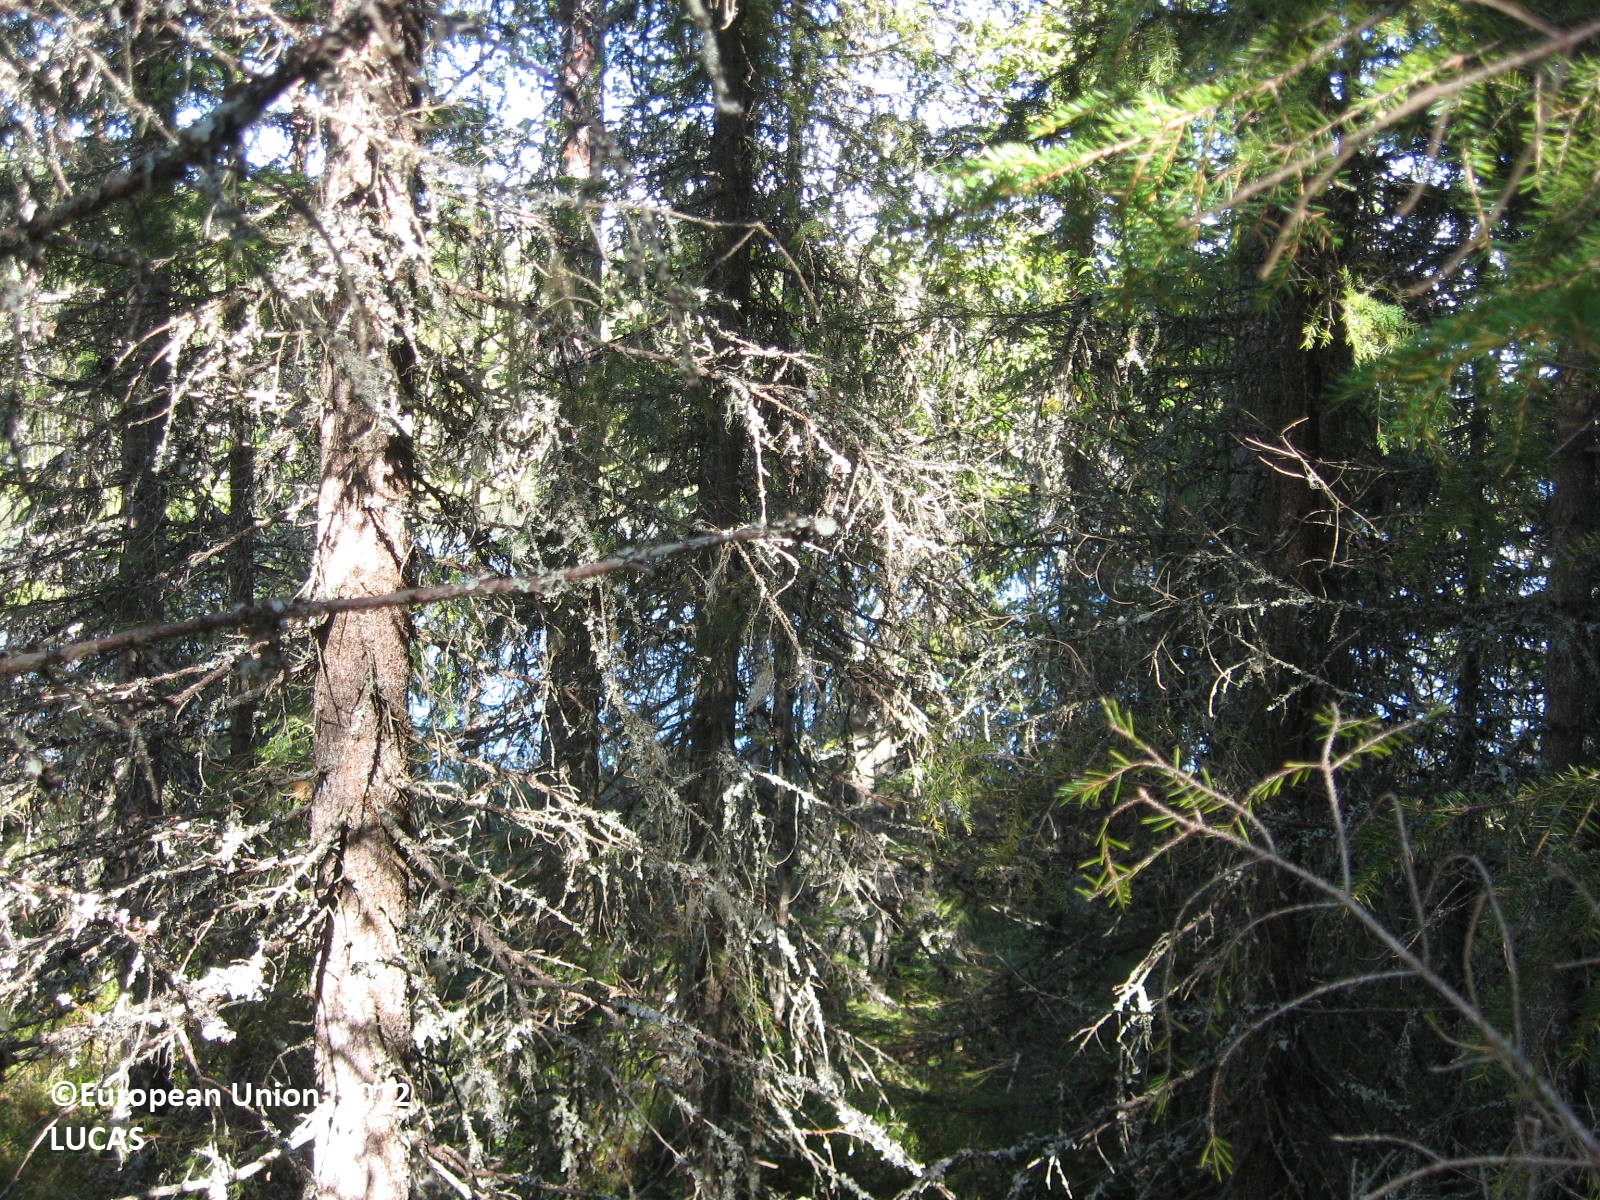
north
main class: Woodland
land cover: Spruce dominated coniferous woodland
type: boreal forest
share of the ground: > 75 %
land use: Forestry
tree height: > 5 m
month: August
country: FI
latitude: 63.7984
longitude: 29.4026
